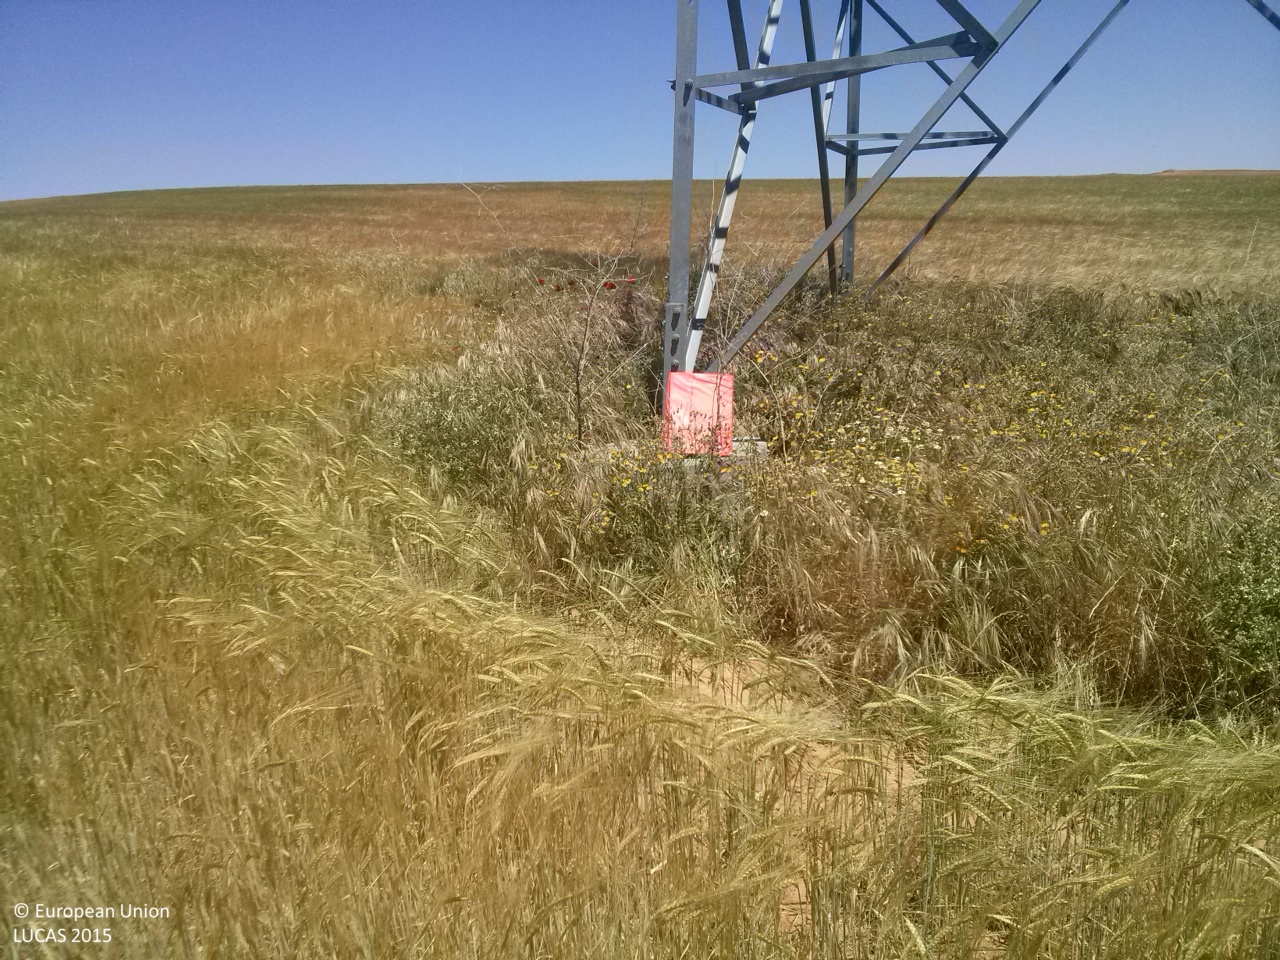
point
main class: Artificial land
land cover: Other artificial areas
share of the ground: < 10 %
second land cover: Barley
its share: > 75 %
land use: Electricity, gas and thermal power distribution
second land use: Agriculture (excluding fallow land and kitchen gardens)
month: May
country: ES
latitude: 40.3074
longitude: -2.7676
